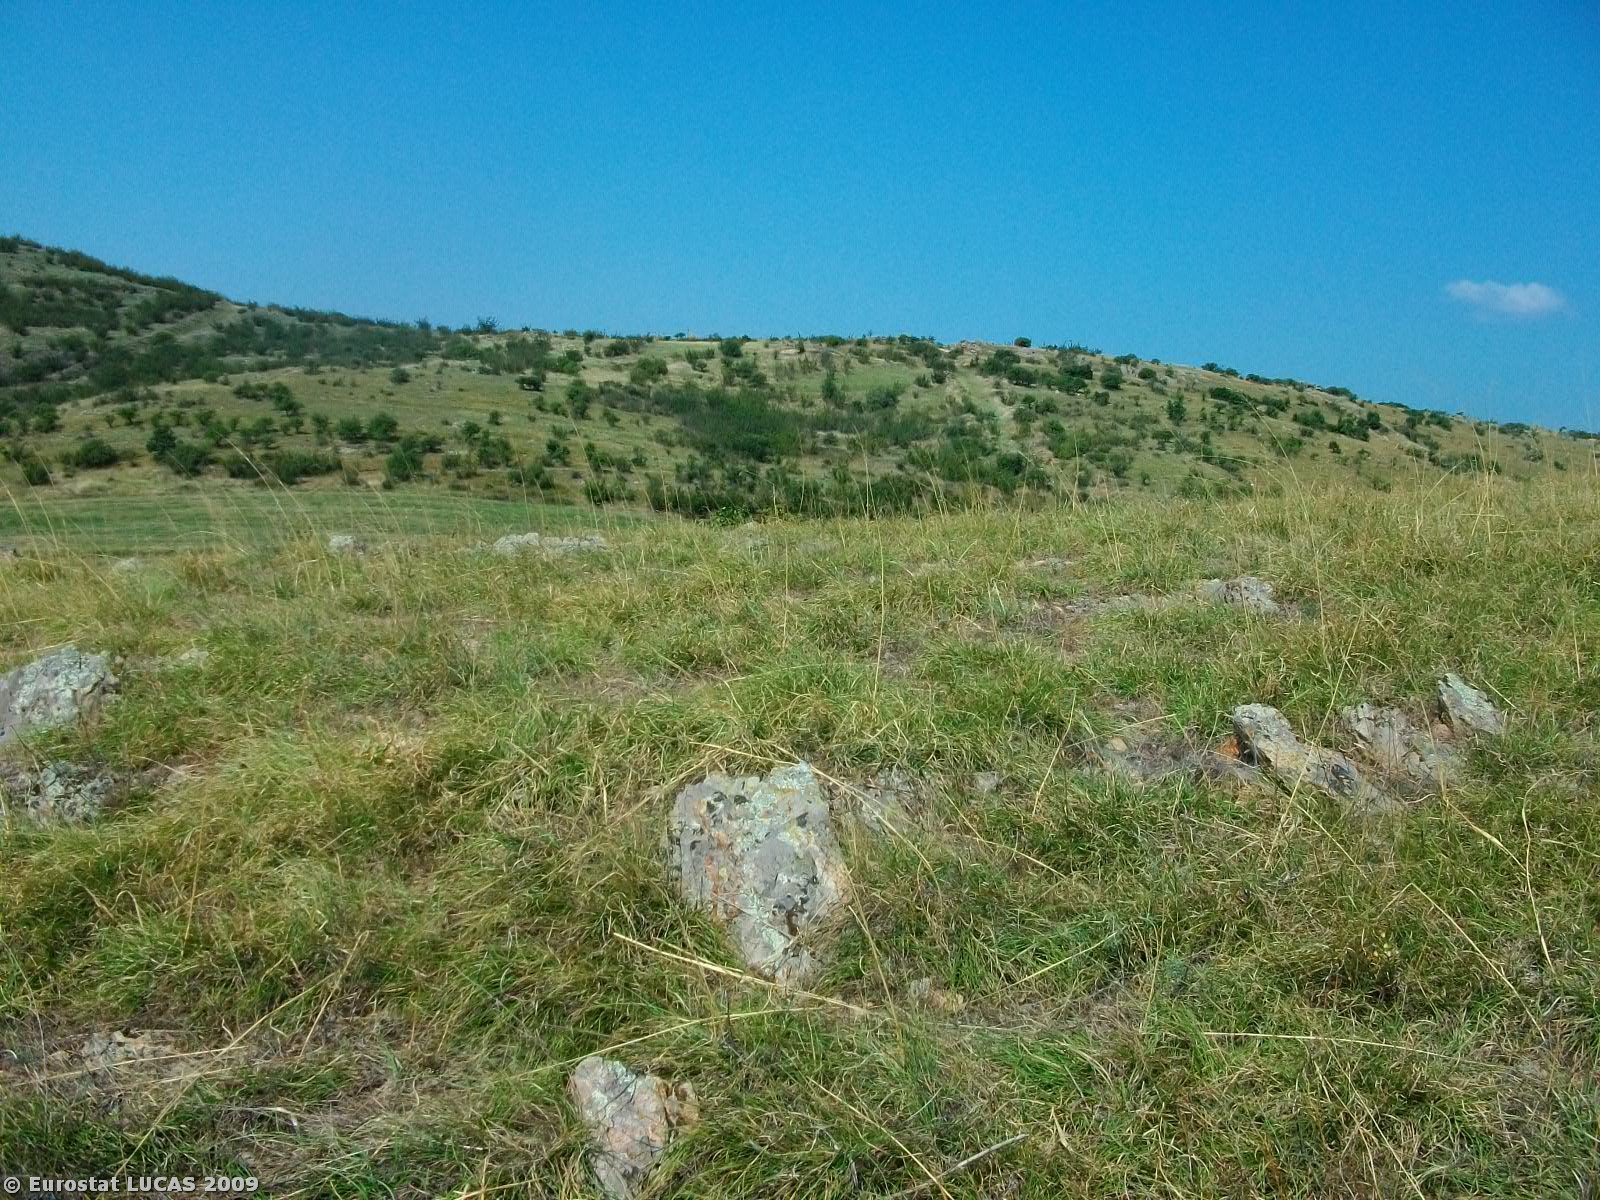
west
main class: Grassland
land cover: Grassland with sparse tree/shrub cover
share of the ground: > 75 %
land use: Unused
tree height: < 5 m
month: July
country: GR
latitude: 41.1298
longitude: 22.7683
